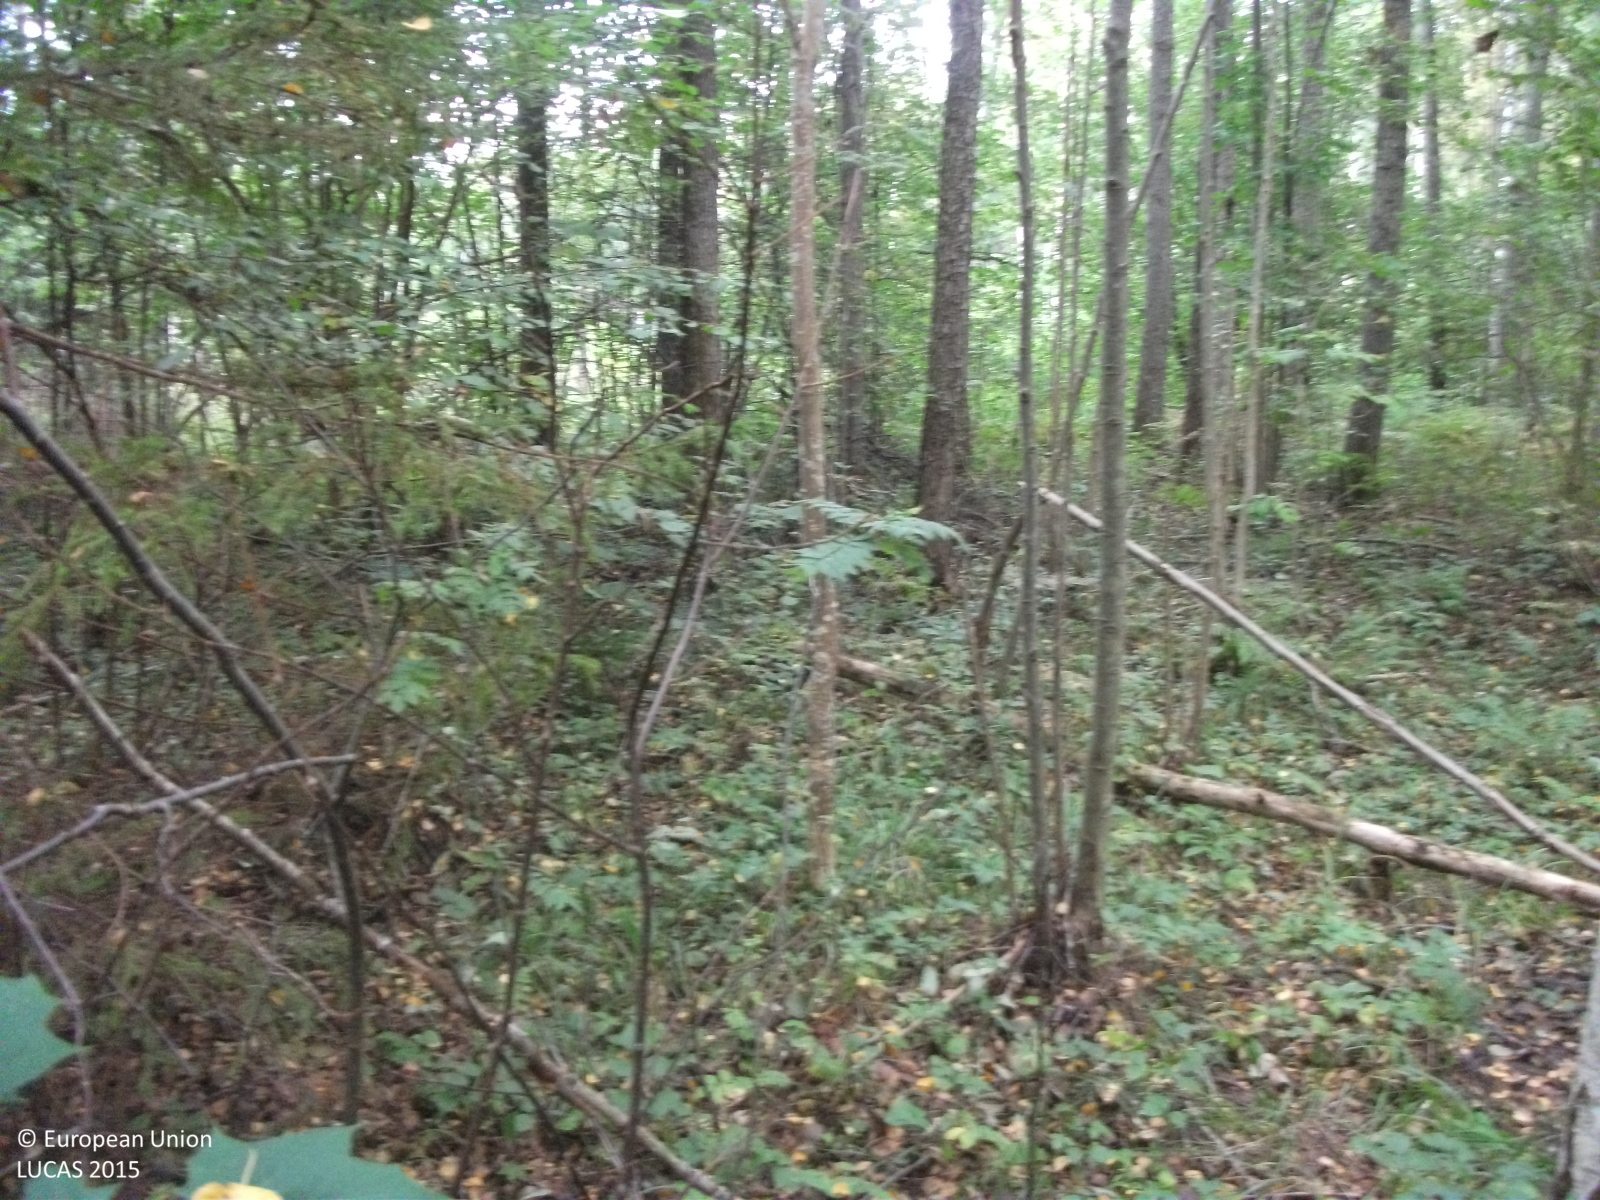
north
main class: Woodland
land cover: Broadleaved woodland
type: non-riverine alder, birch or aspen forest
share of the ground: > 75 %
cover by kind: broadleaved forest trees 85 %, herbaceous plants 10 %, shrubs 5 %
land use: Forestry
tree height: > 5 m
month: September
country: LV
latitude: 57.7088
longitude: 24.4381
